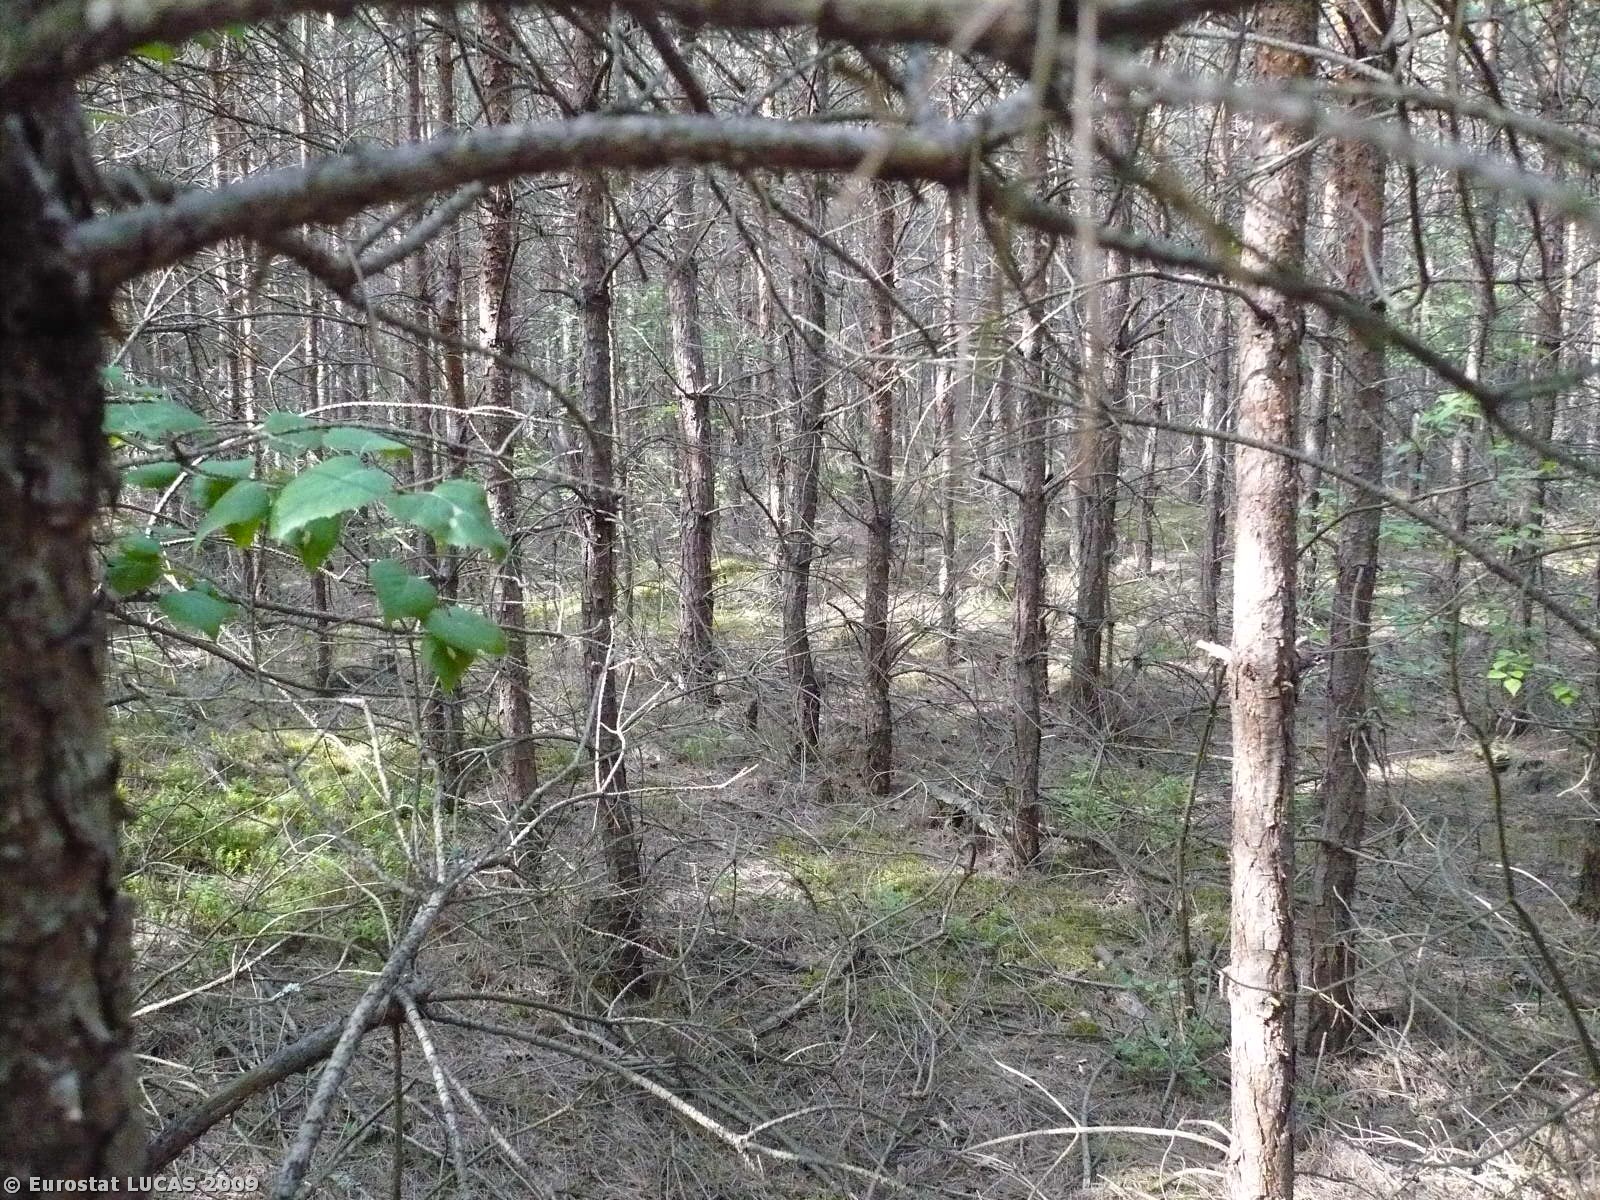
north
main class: Woodland
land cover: Coniferous woodland
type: hemiboreal forest and nemoral coniferous forest and mixed broadleaved-coniferous forest
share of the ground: > 75 %
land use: Forestry
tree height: > 5 m
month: May
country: PL
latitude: 52.0854
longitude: 15.1547
